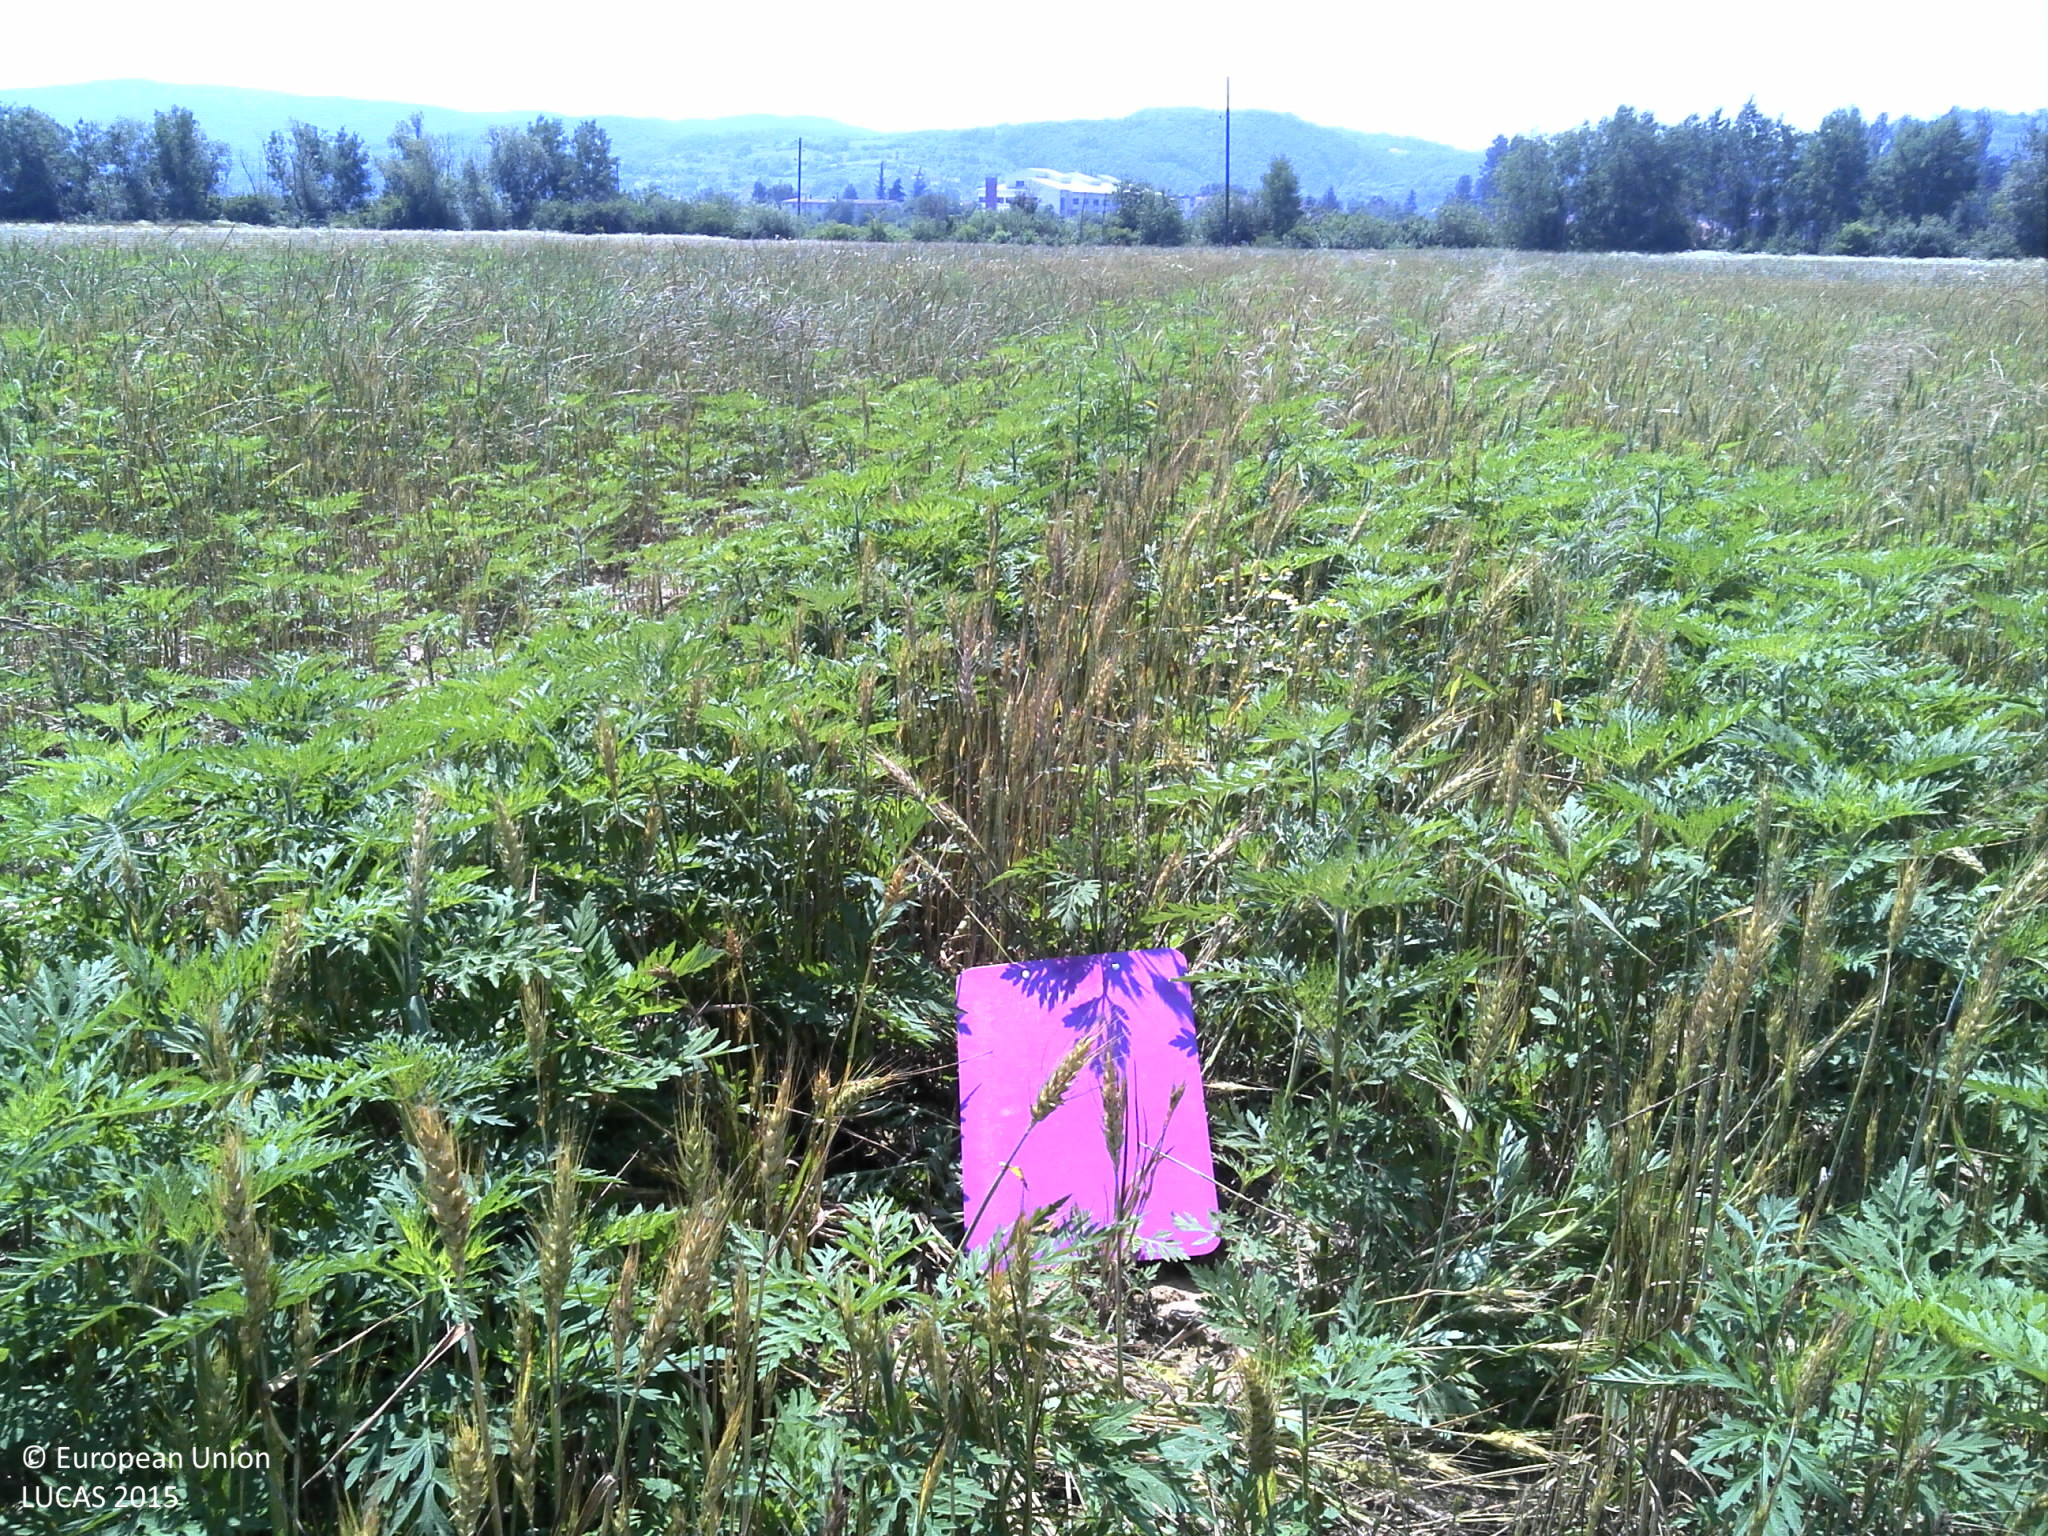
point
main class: Cropland
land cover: Barley
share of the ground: > 75 %
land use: Agriculture (excluding fallow land and kitchen gardens)
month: June
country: HR
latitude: 45.3498
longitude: 17.6983
